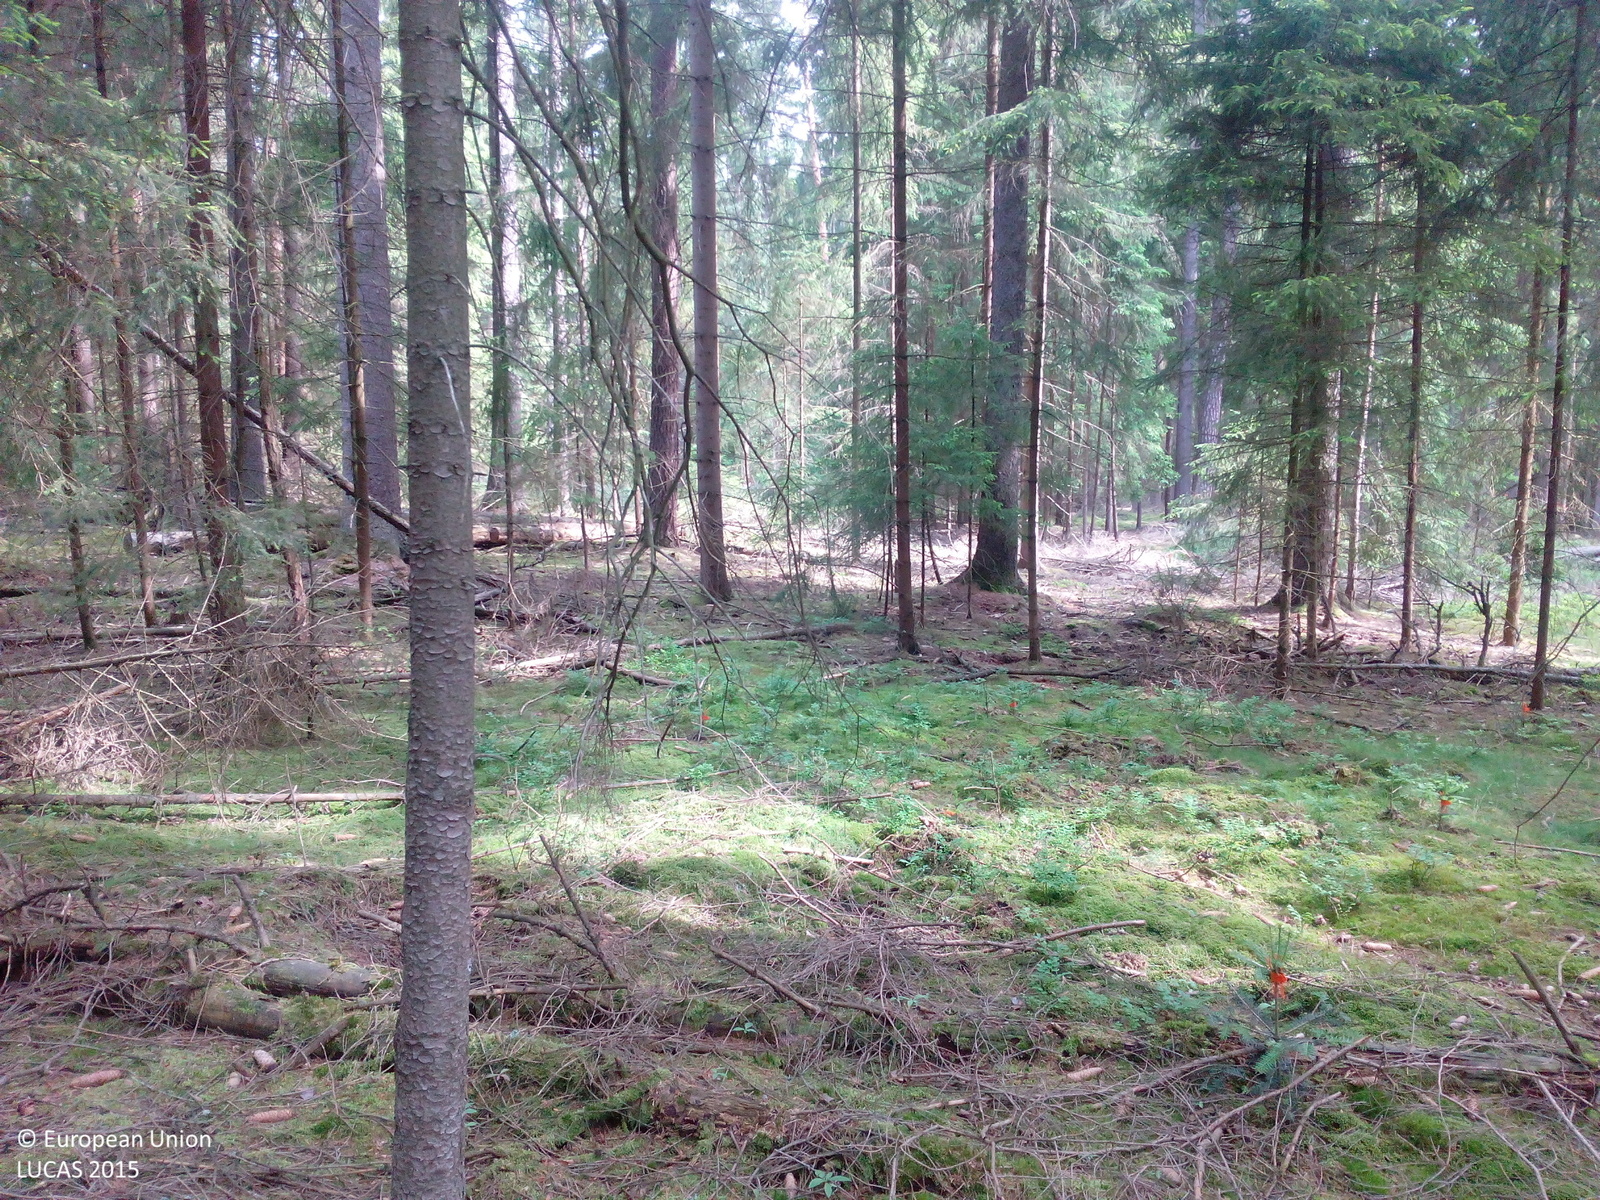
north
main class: Woodland
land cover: Spruce dominated coniferous woodland
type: hemiboreal forest and nemoral coniferous forest and mixed broadleaved-coniferous forest
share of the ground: 50 - 75 %
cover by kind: coniferous forest trees 65 %, herbaceous plants 20 %, shrubs 10 %
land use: Forestry
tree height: > 5 m
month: June
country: DE
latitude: 50.0721
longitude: 12.2491
